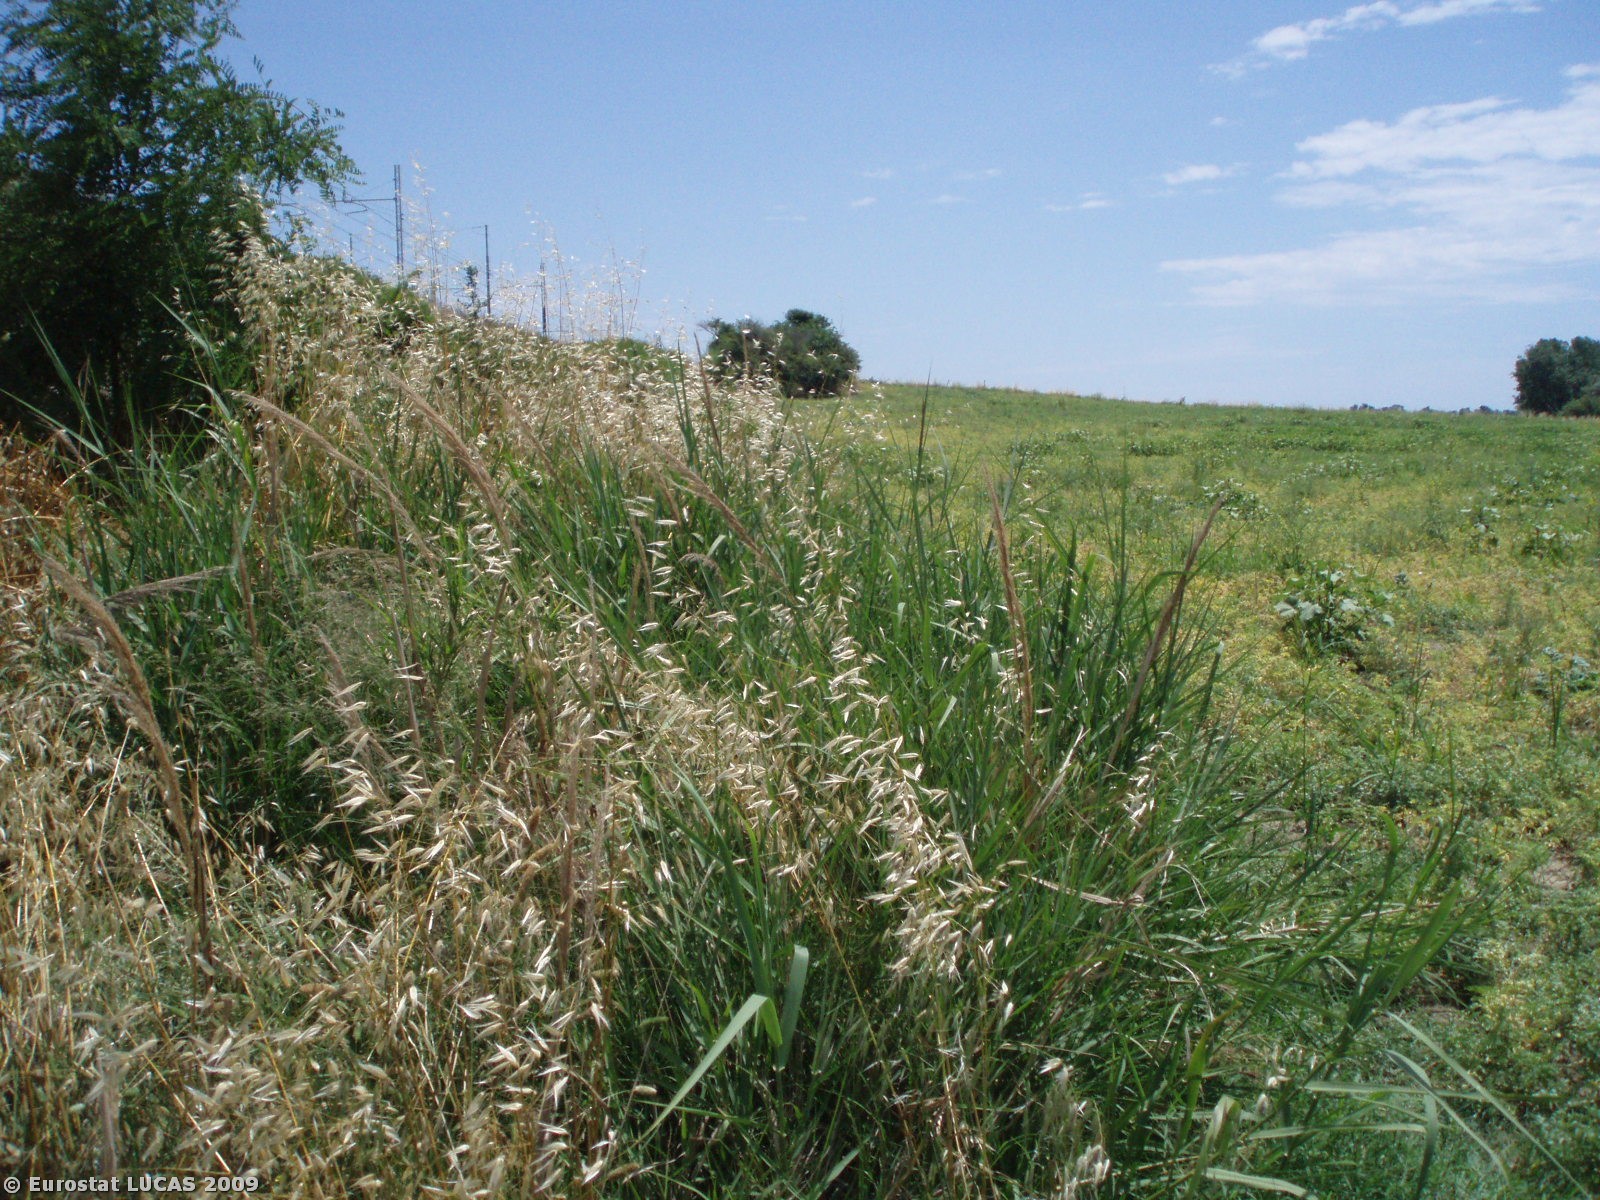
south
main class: Cropland
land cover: Sunflower
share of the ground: > 75 %
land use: Agriculture (excluding fallow land and kitchen gardens)
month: June
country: IT
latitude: 42.3526
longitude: 11.5848
